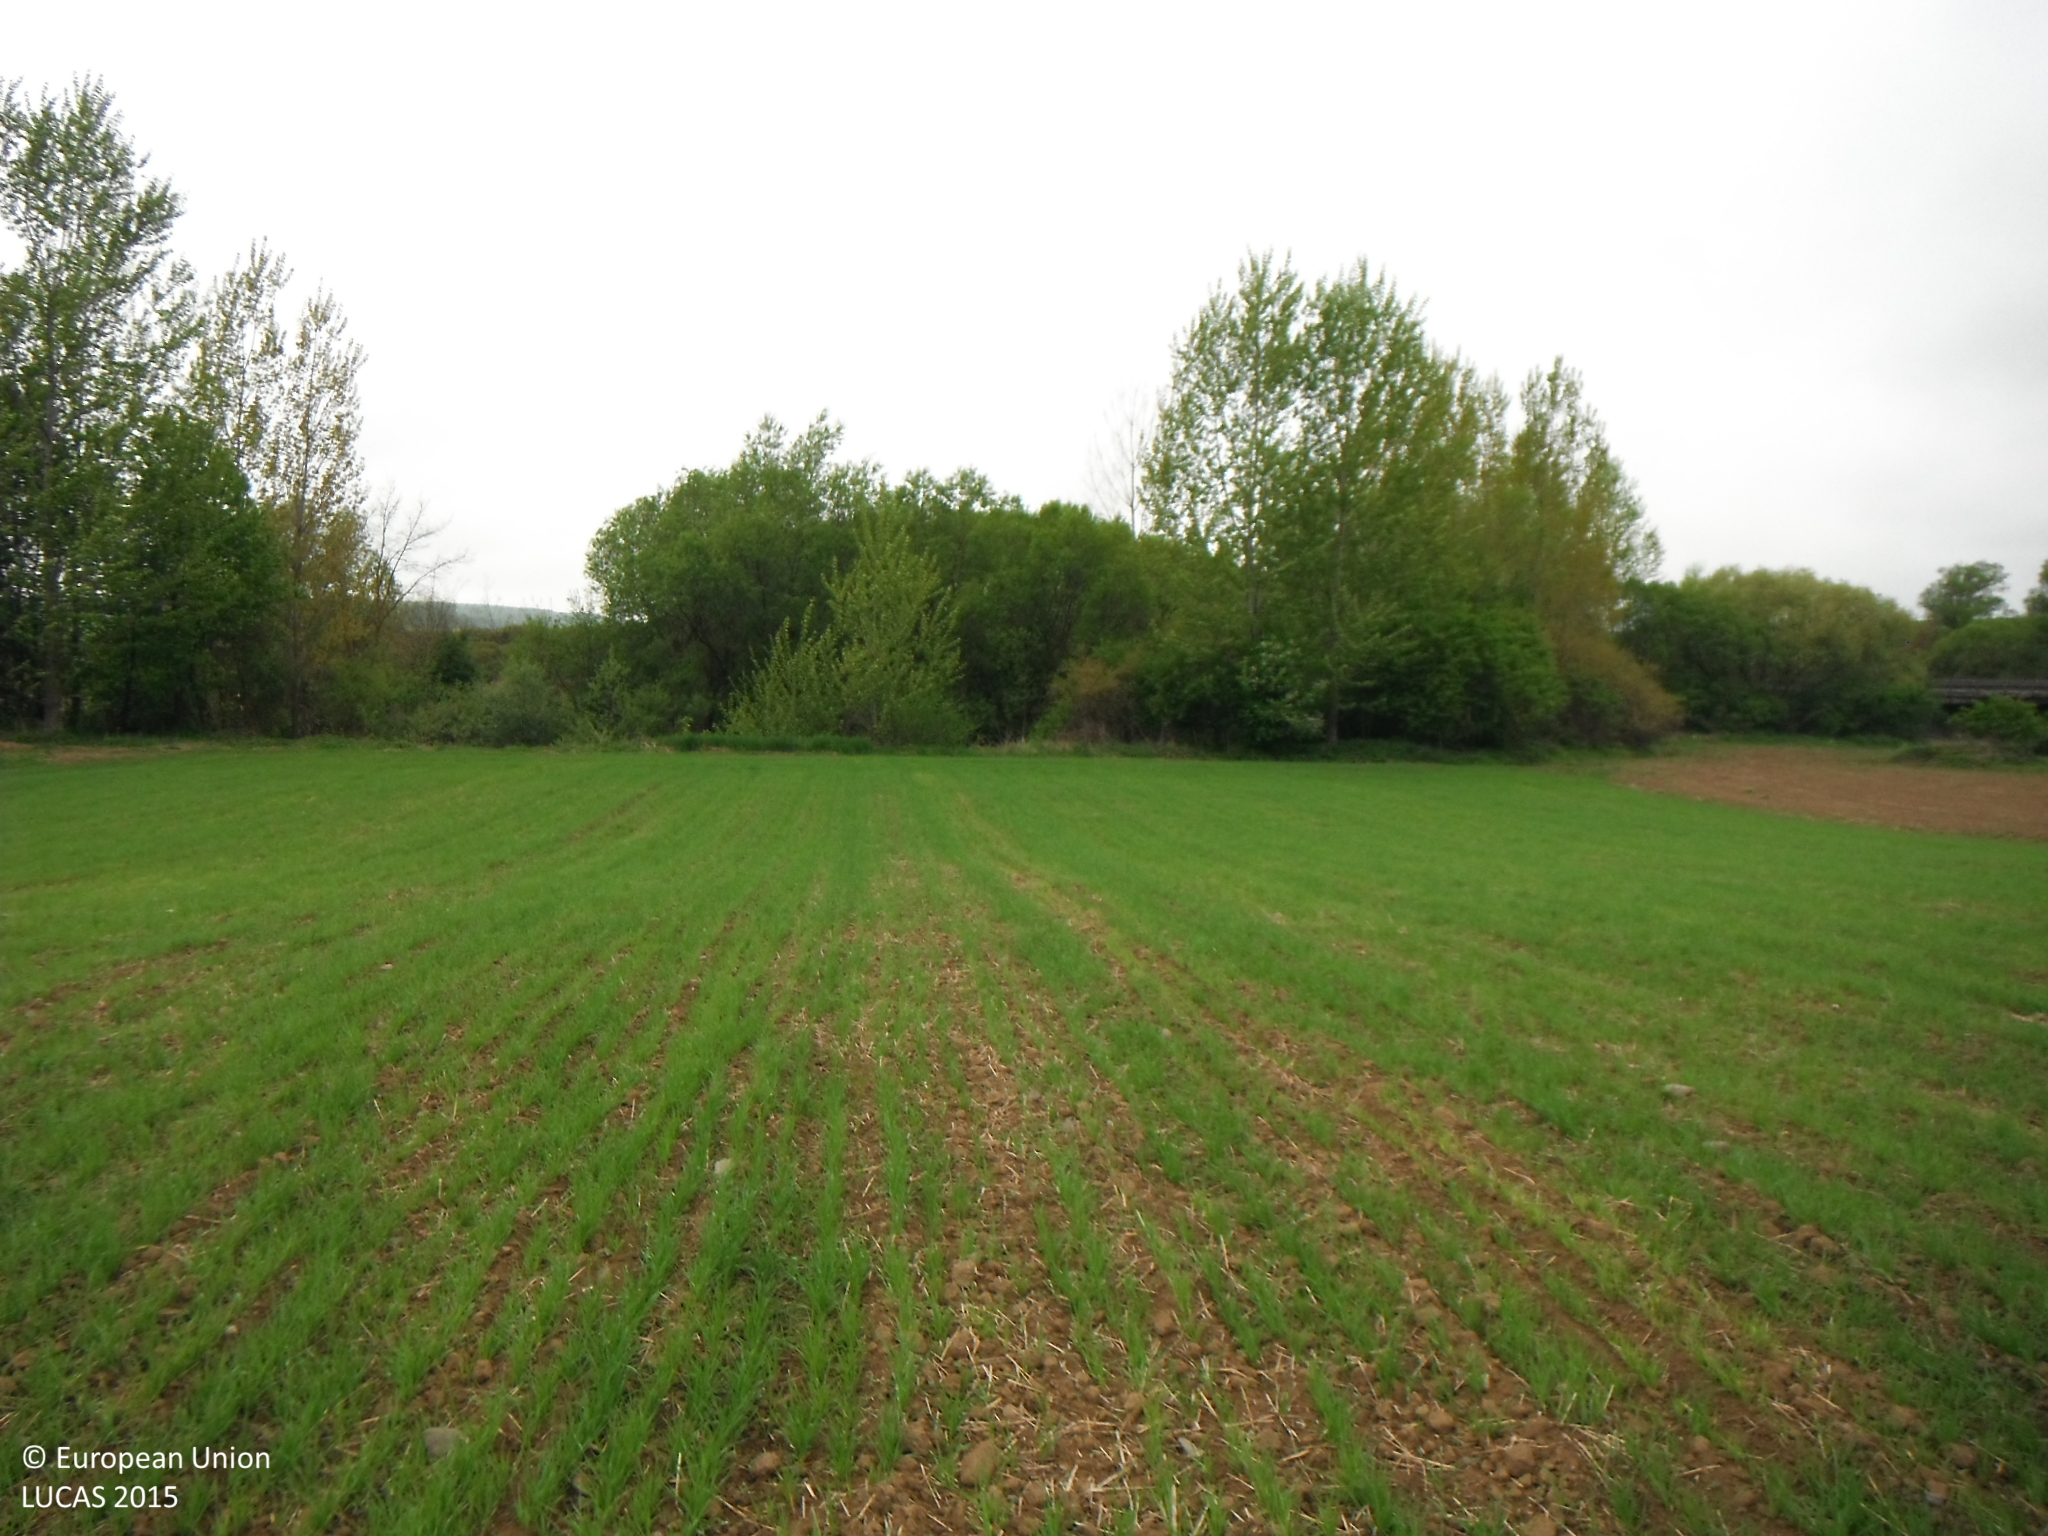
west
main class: Cropland
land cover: Barley
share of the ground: 50 - 75 %
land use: Agriculture (excluding fallow land and kitchen gardens)
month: May
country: SK
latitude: 48.7356
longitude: 21.4274
